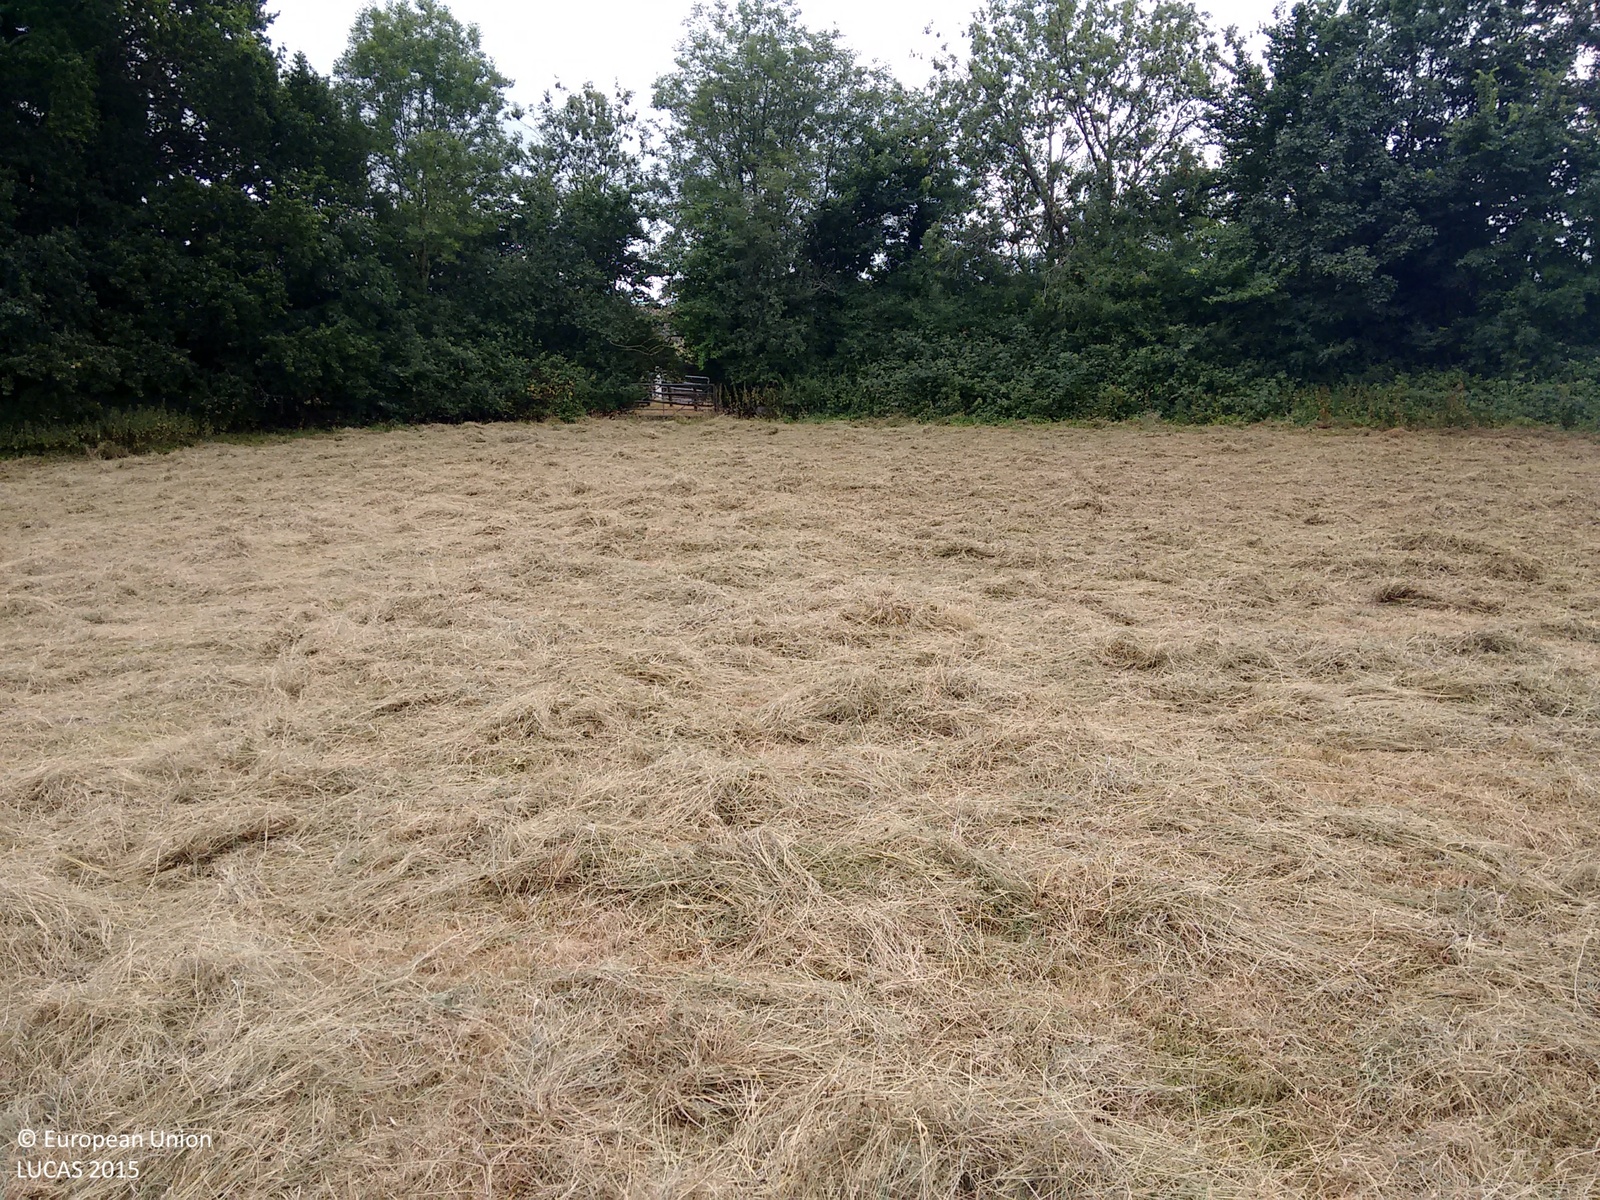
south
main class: Grassland
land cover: Grassland without tree/shrub cover
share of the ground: > 75 %
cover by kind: herbaceous plants 100 %
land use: Agriculture (excluding fallow land and kitchen gardens)
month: July
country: GB
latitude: 51.0788
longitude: -0.4723
